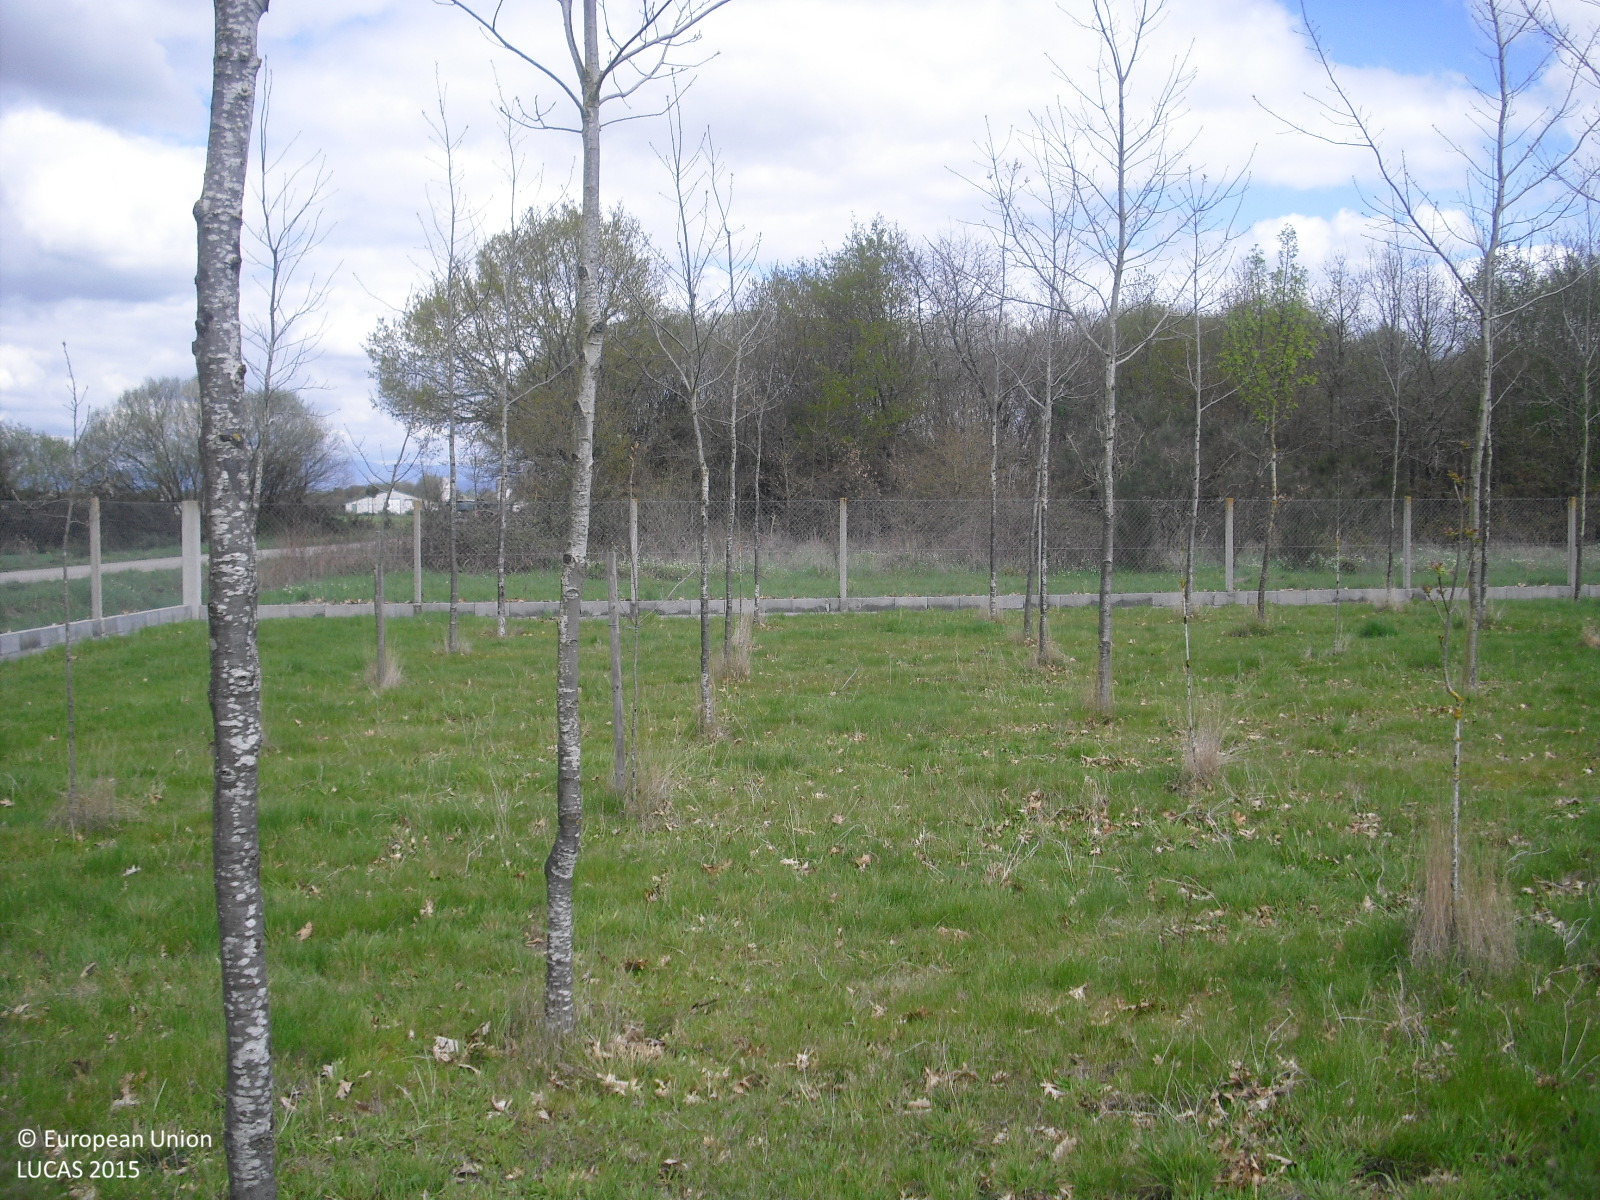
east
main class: Woodland
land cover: Broadleaved woodland
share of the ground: 10 - 25 %
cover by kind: herbaceous plants 80 %, broadleaved forest trees 20 %
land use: Forestry
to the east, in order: Broadleaved woodland; Fences; Shrubland without tree cover; Broadleaved woodland; Shruby margins; Ditches and canals; Grassland without tree/shrub cover
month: April
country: ES
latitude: 42.0371
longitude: -7.8168
